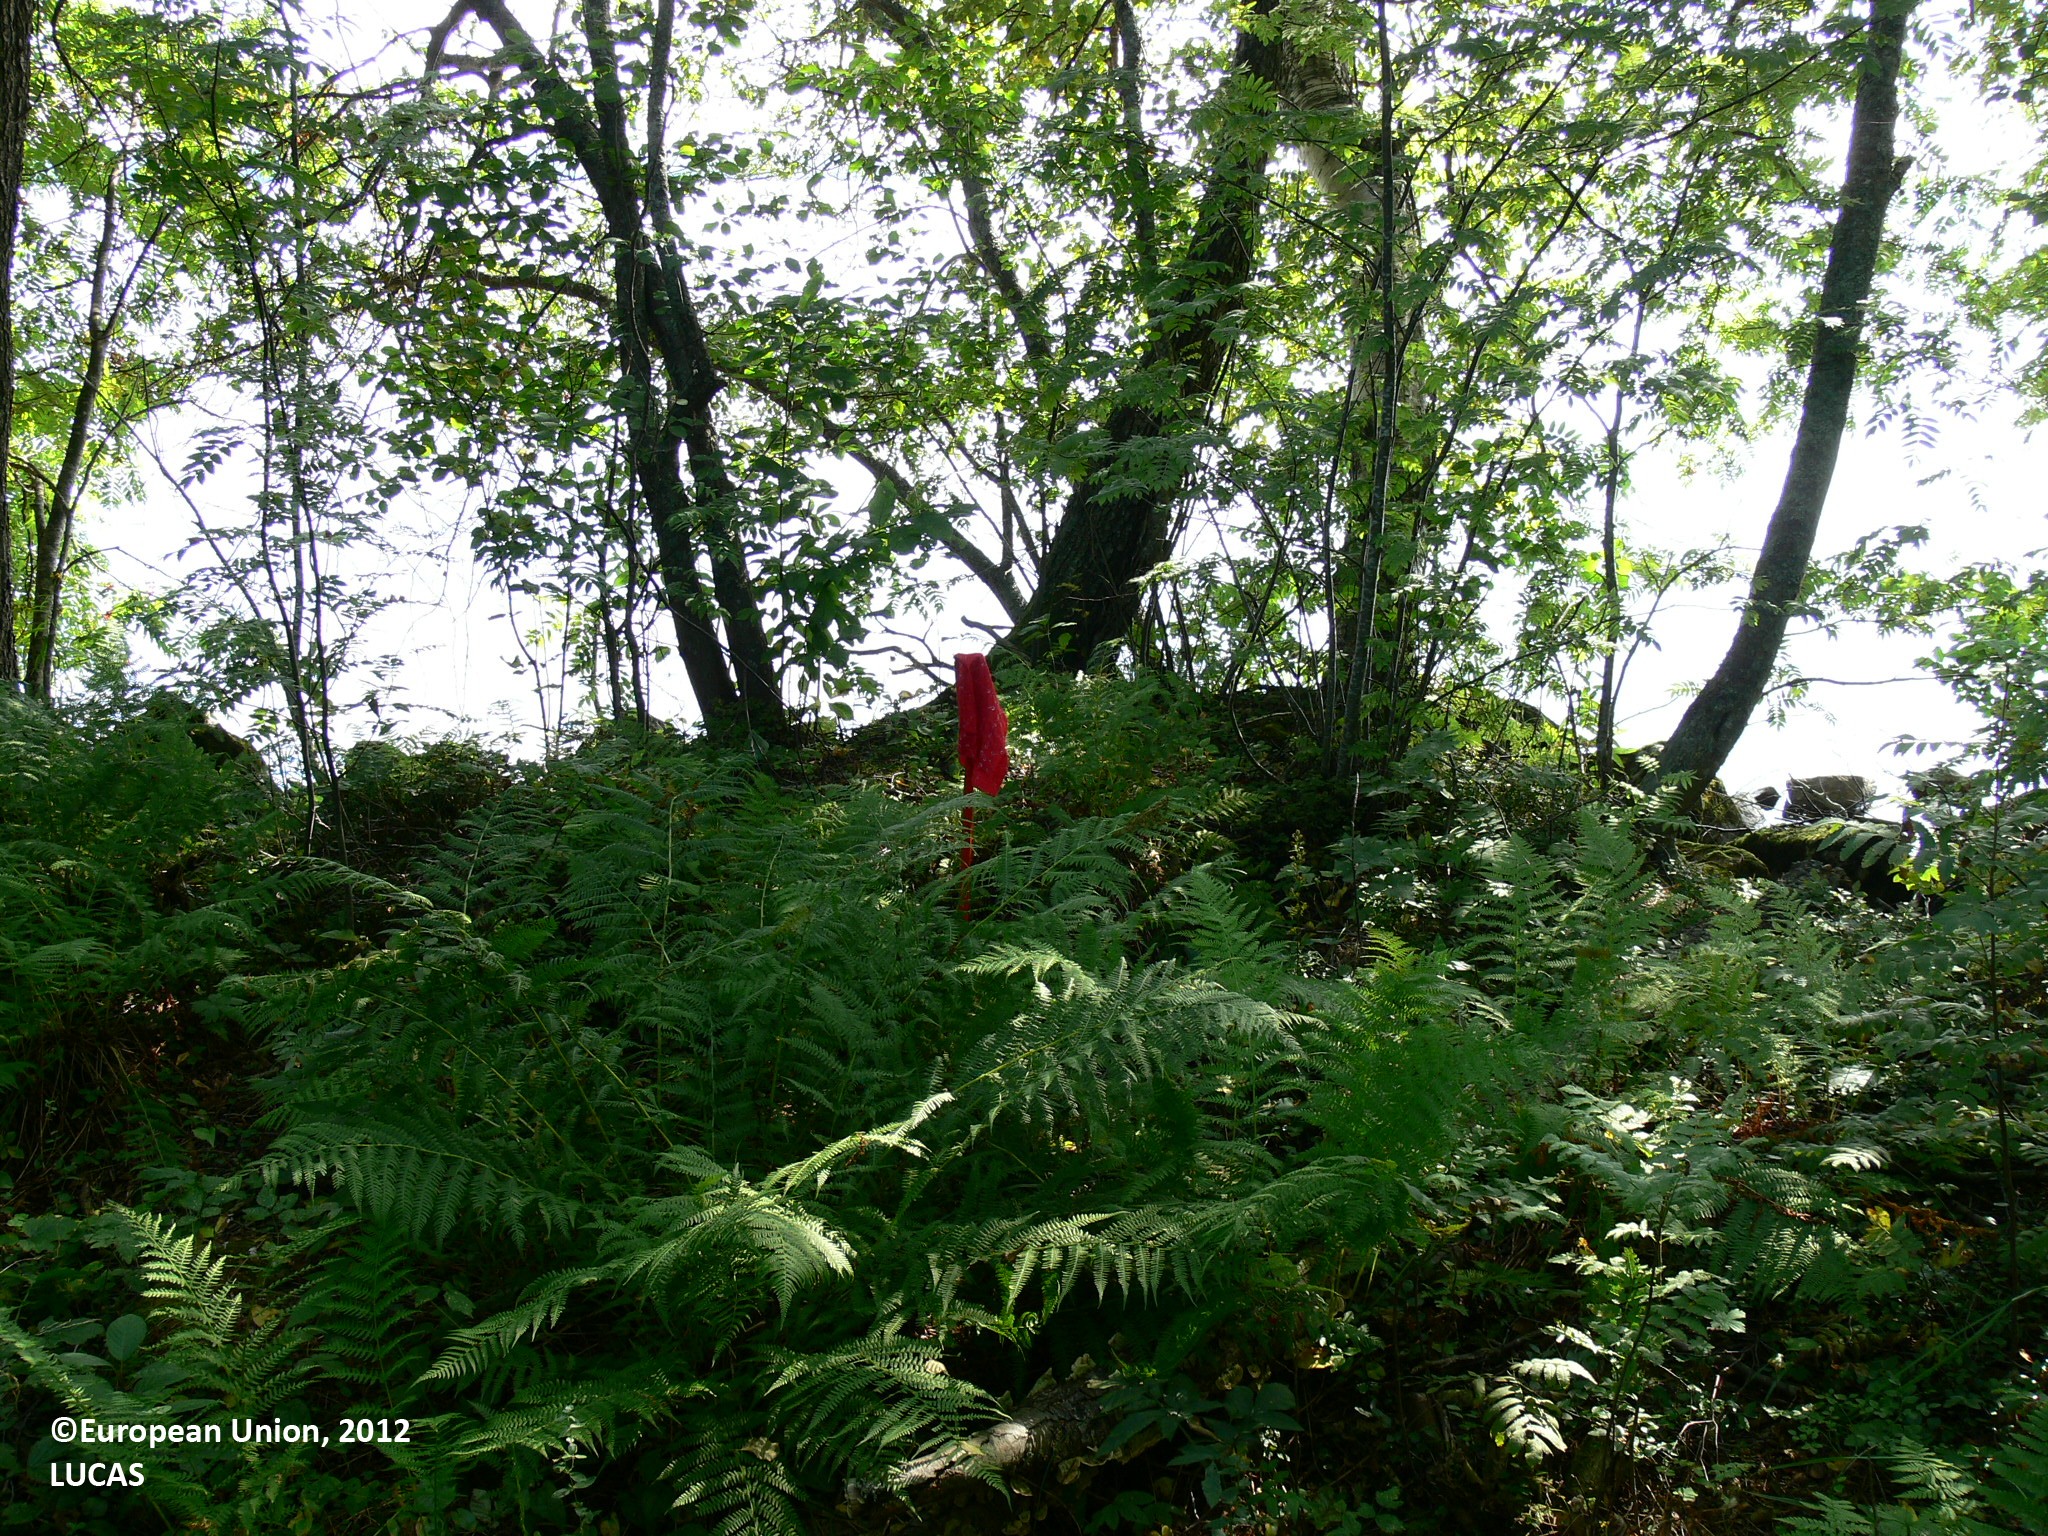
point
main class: Woodland
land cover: Broadleaved woodland
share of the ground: 50 - 75 %
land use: Forestry
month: August
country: FI
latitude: 61.9180
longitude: 30.0150
